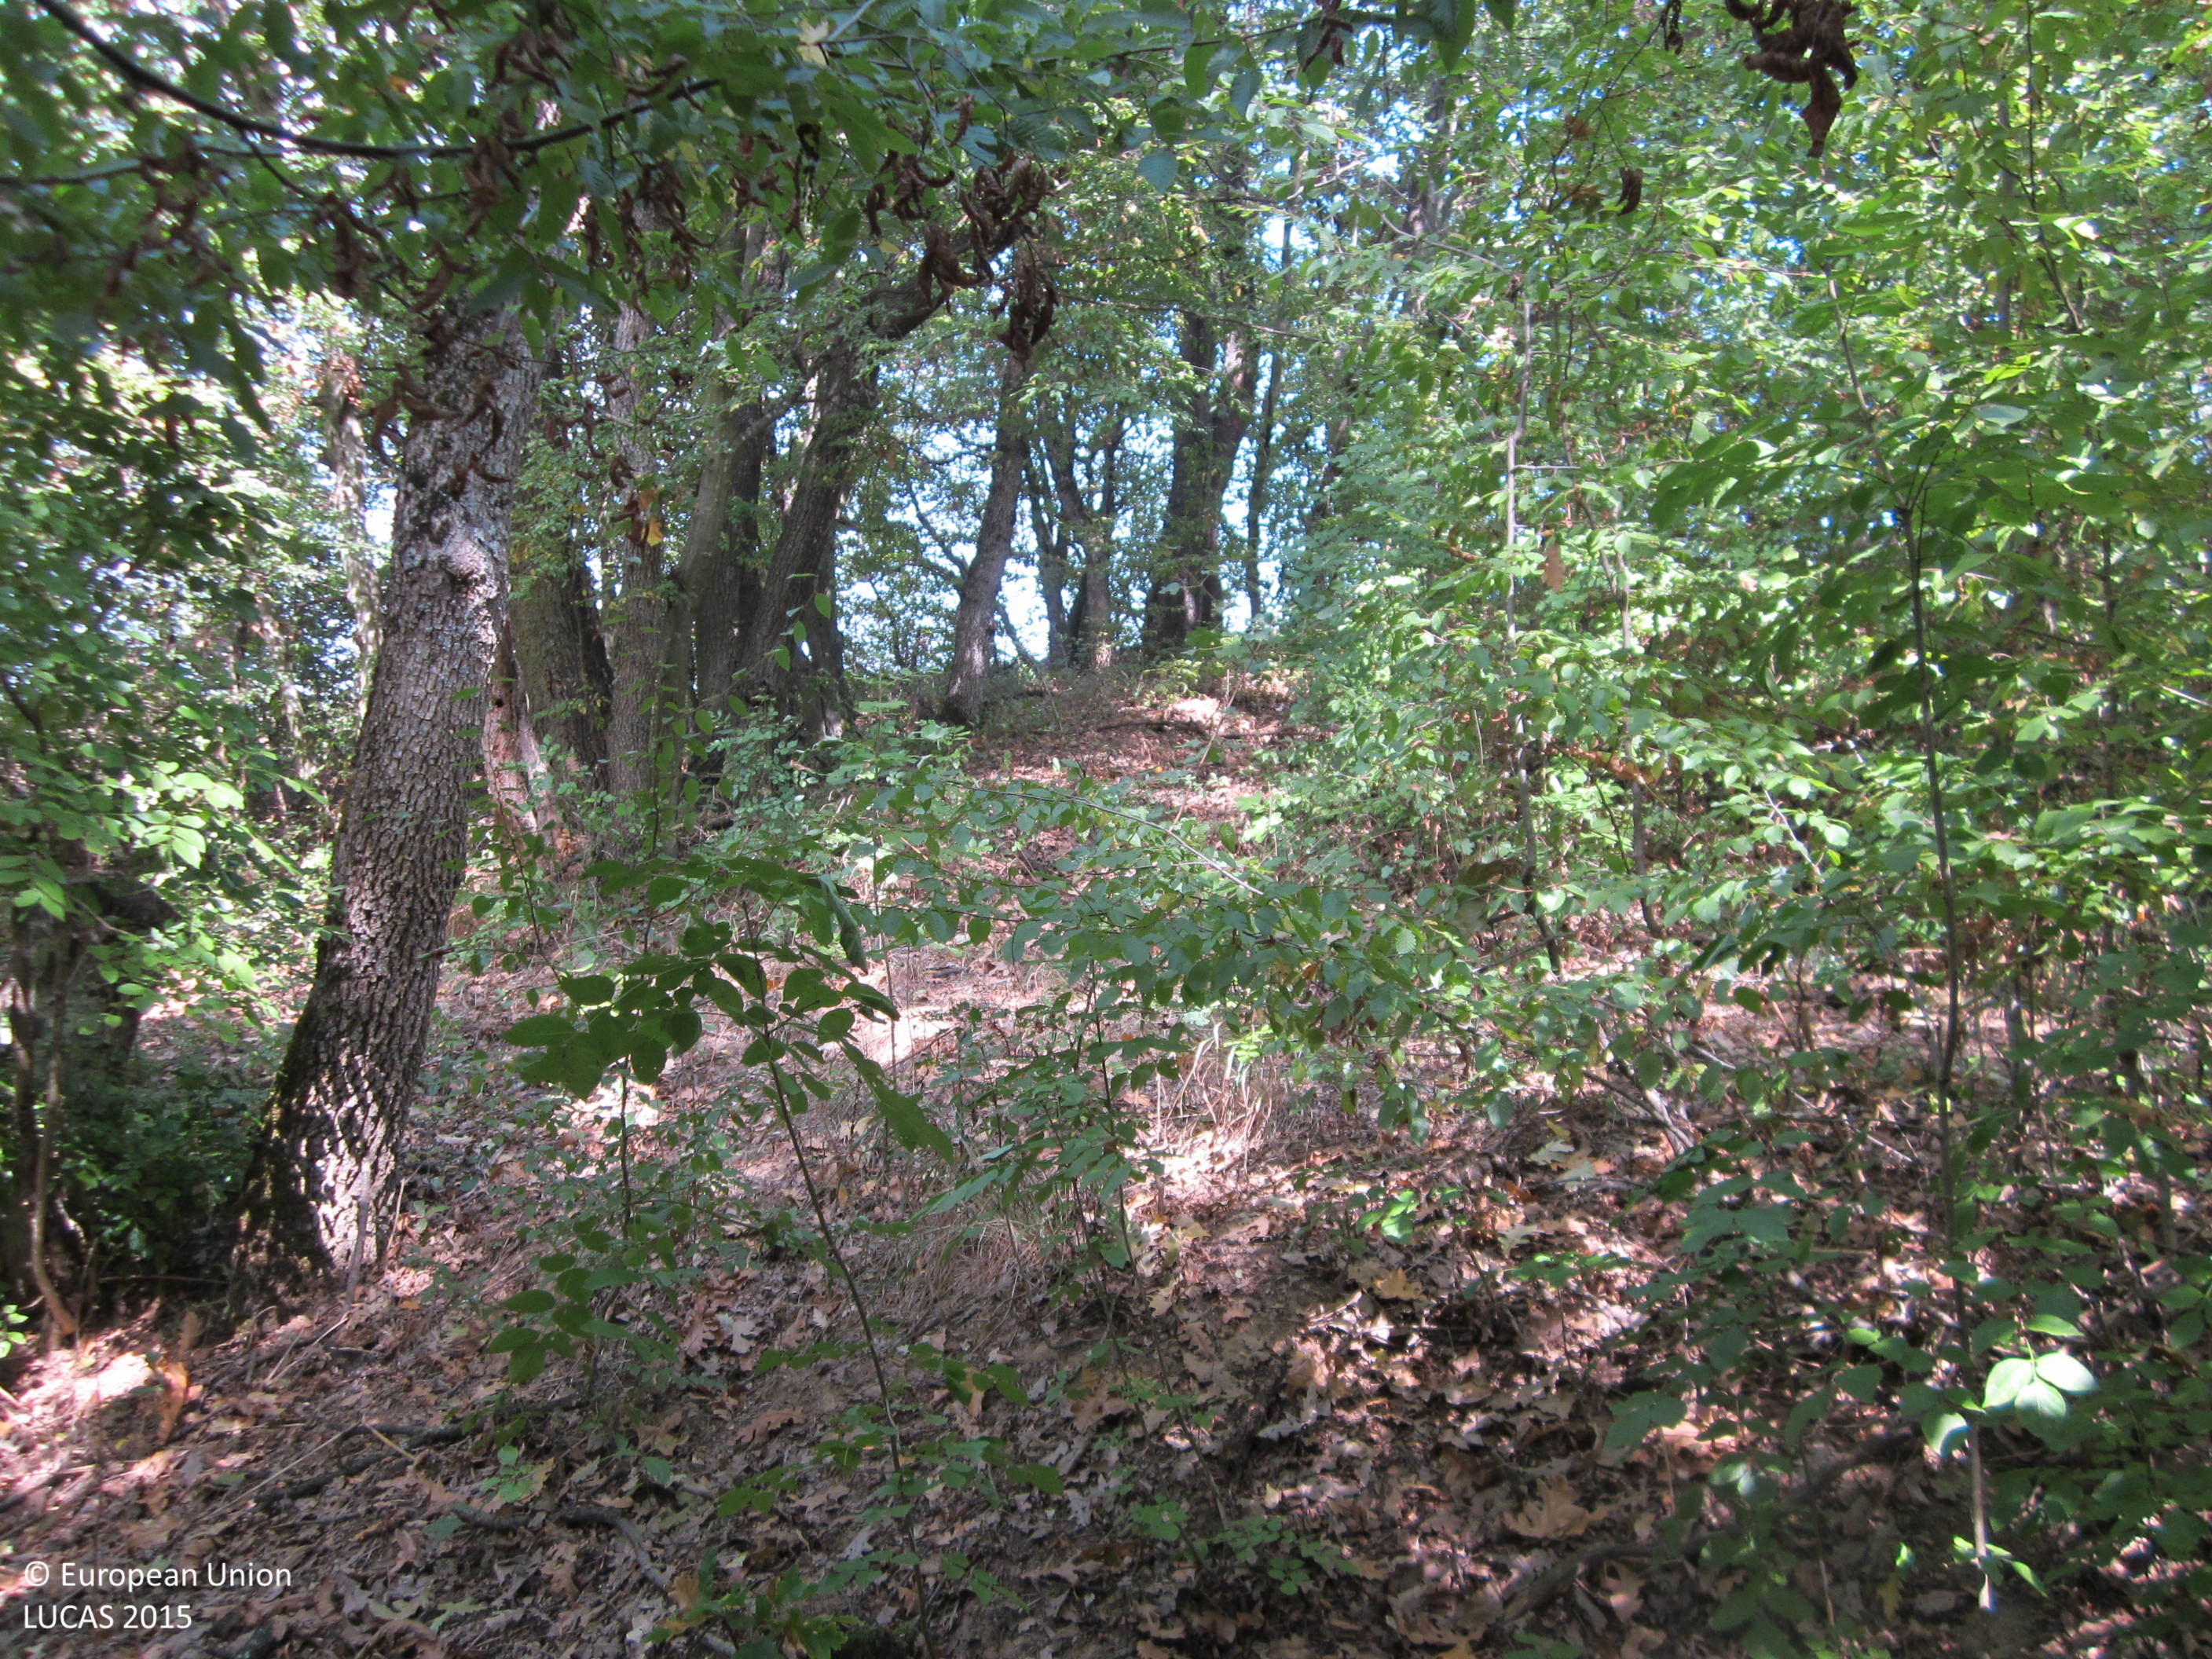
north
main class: Woodland
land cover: Broadleaved woodland
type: mesophytic deciduous forest
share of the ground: > 75 %
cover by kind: broadleaved forest trees 90 %, shrubs 5 %, unconsolidated bare surface 5 %
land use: Forestry
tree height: > 5 m
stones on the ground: < 10 %
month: September
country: BG
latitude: 42.8042
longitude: 27.1209
